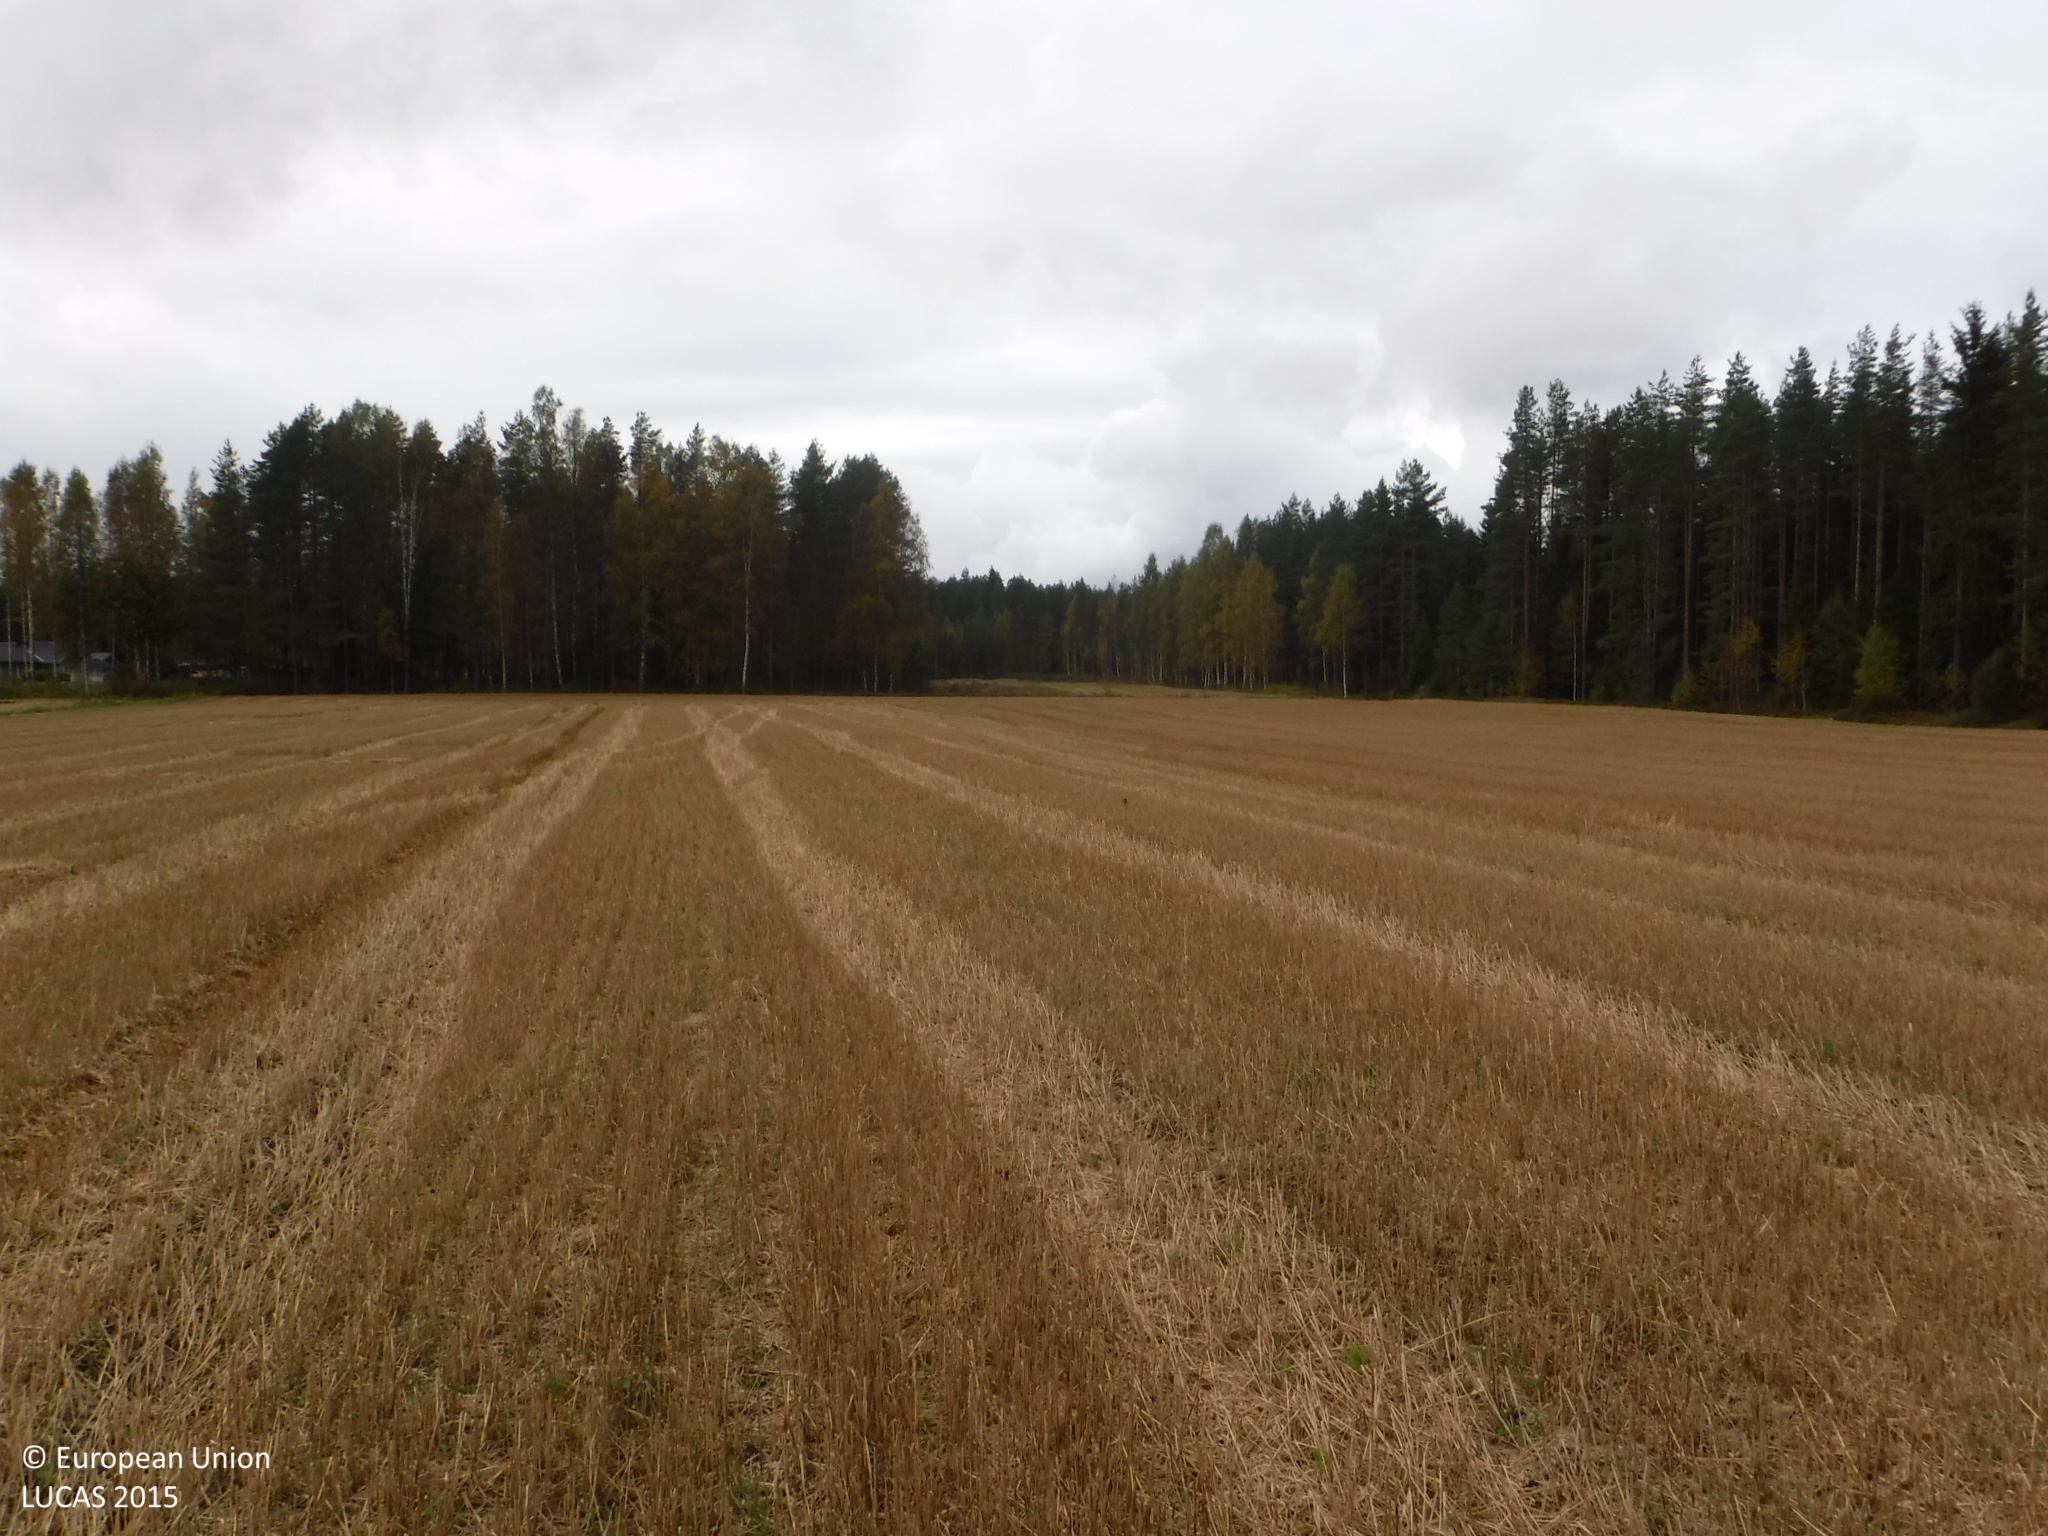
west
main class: Cropland
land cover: Barley
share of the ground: > 75 %
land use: Agriculture (excluding fallow land and kitchen gardens)
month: September
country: FI
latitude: 62.0206
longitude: 22.2267
